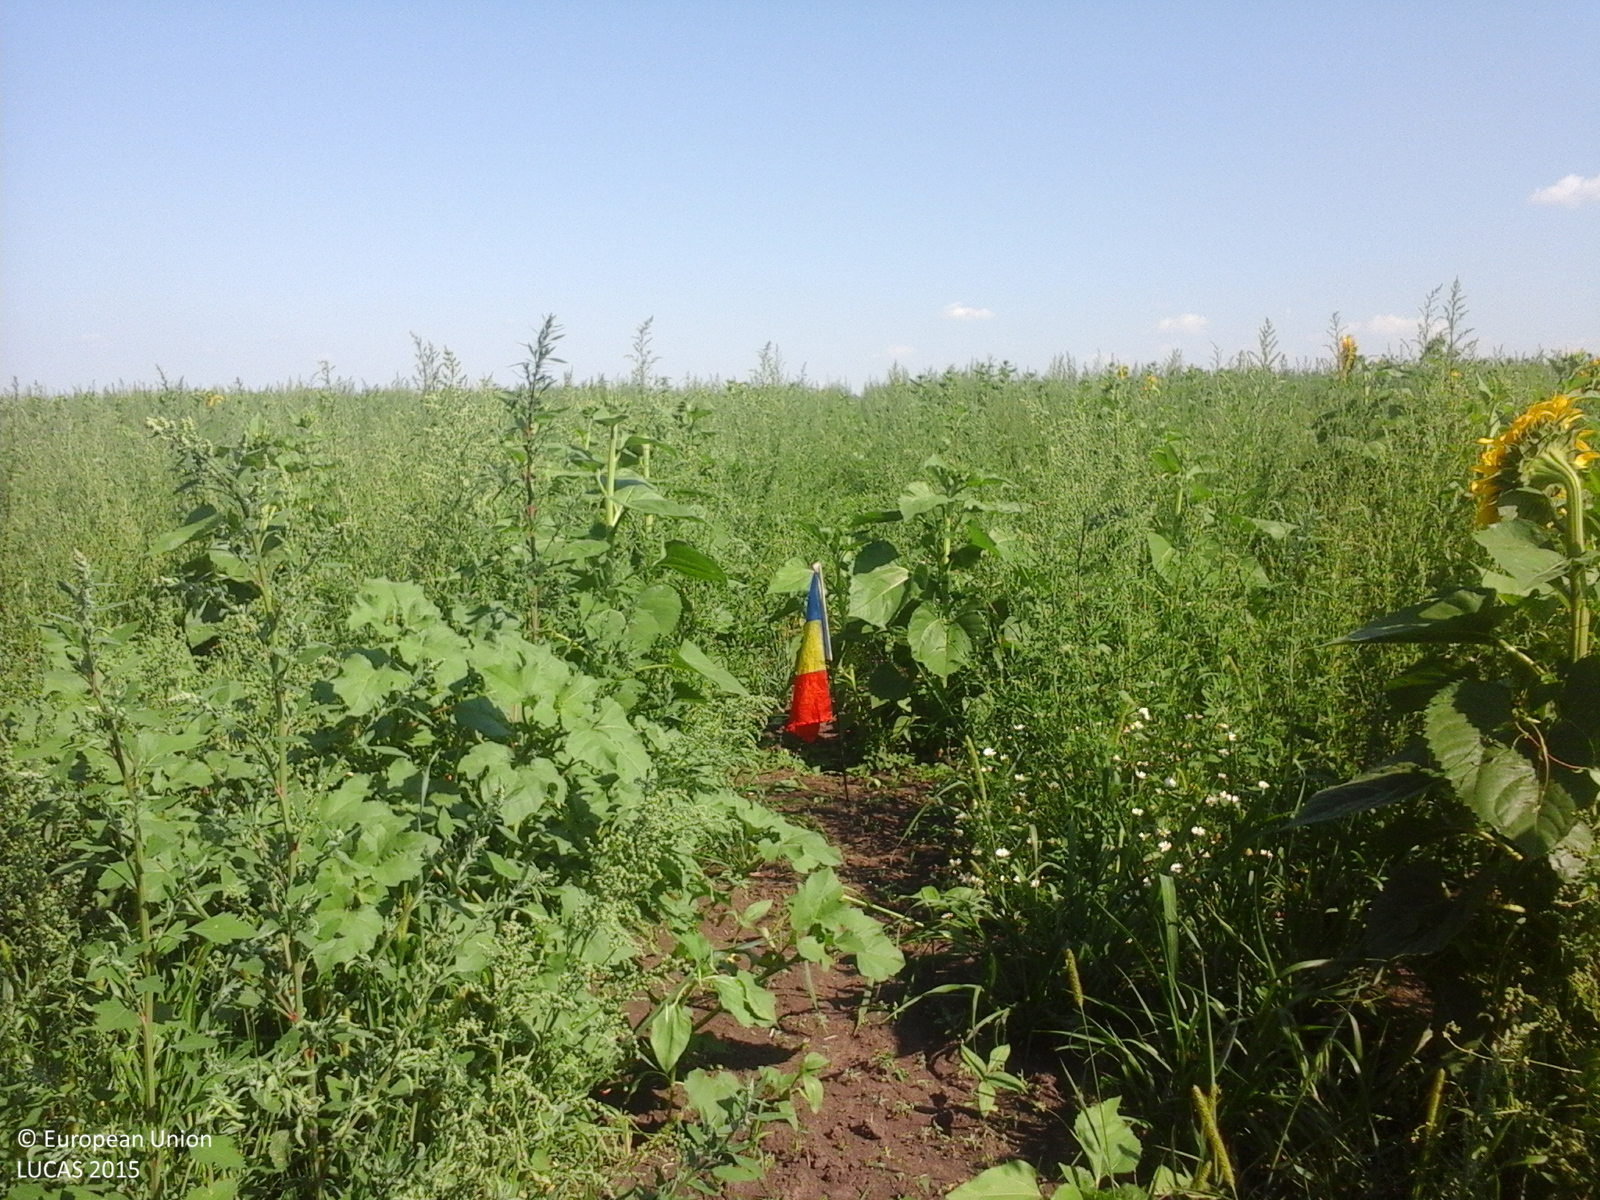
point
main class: Grassland
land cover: Spontaneously vegetated surfaces
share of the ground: > 75 %
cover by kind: herbaceous plants 100 %
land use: Fallow land
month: July
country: RO
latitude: 44.2542
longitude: 24.6630
